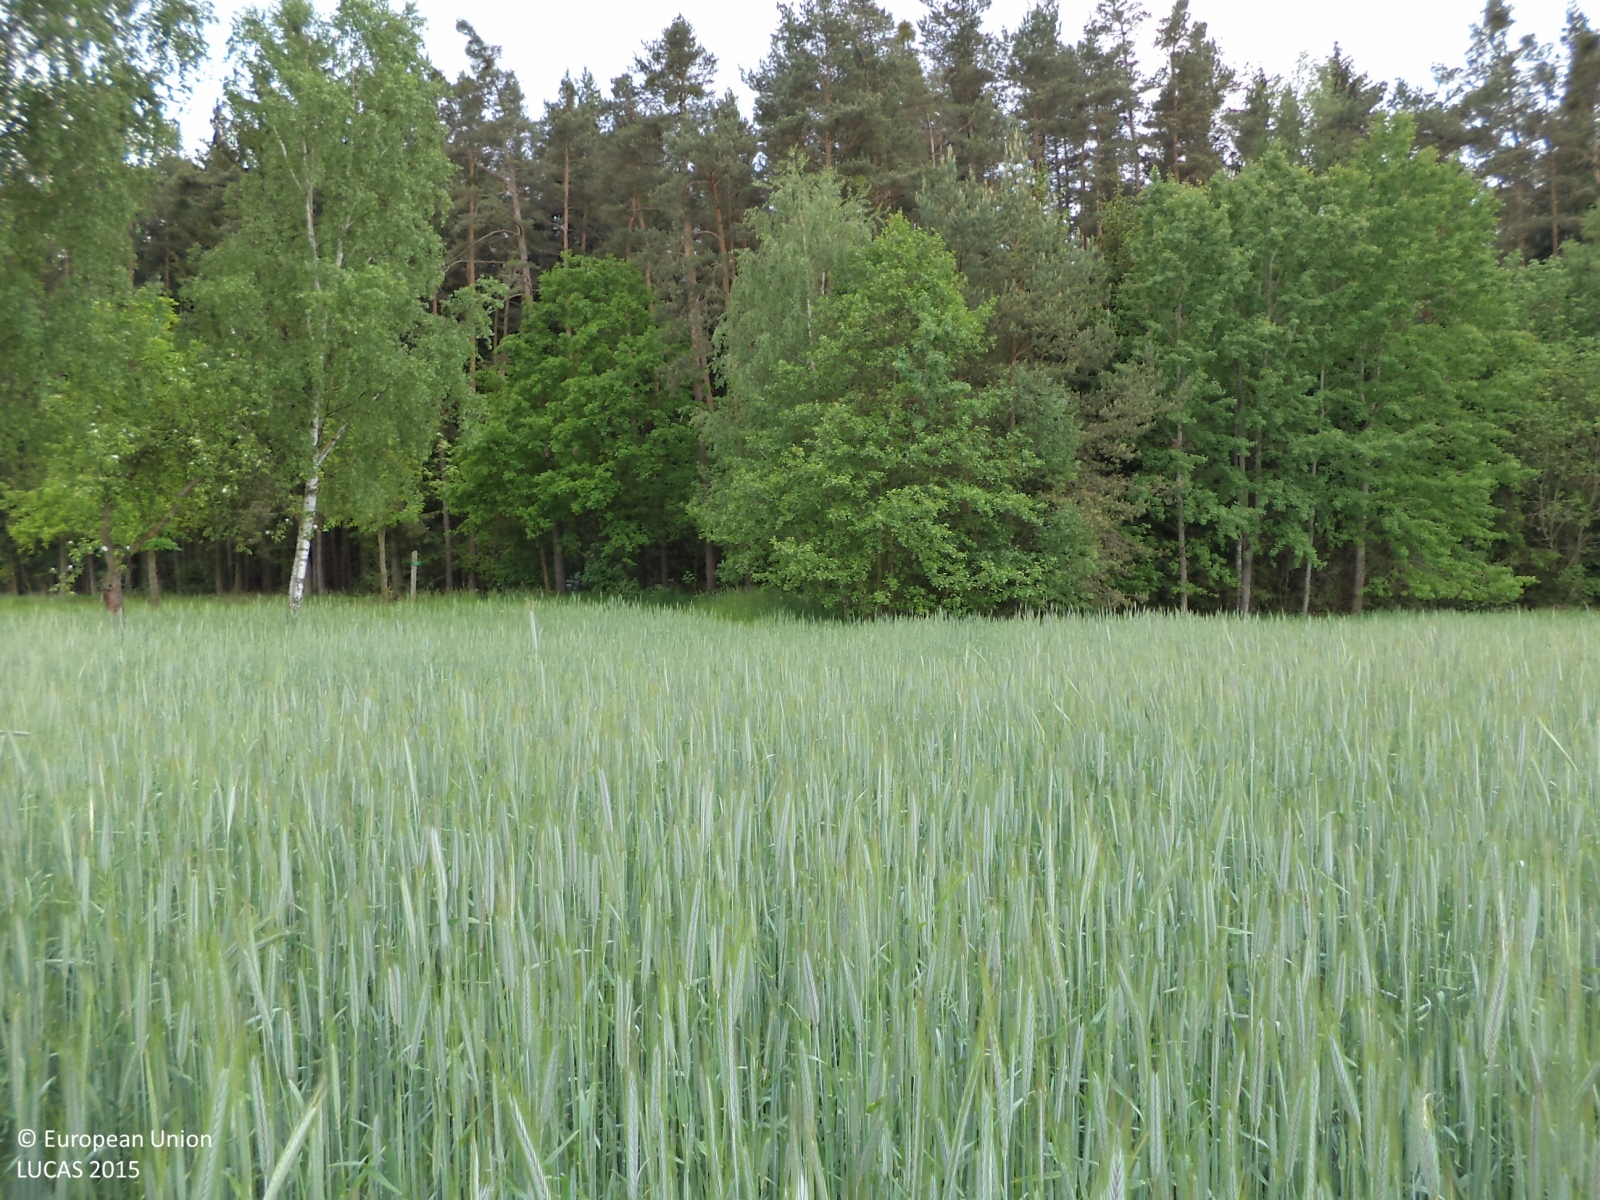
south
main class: Cropland
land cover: Rye
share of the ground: > 75 %
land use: Agriculture (excluding fallow land and kitchen gardens)
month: May
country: CZ
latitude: 49.2019
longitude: 14.7642
